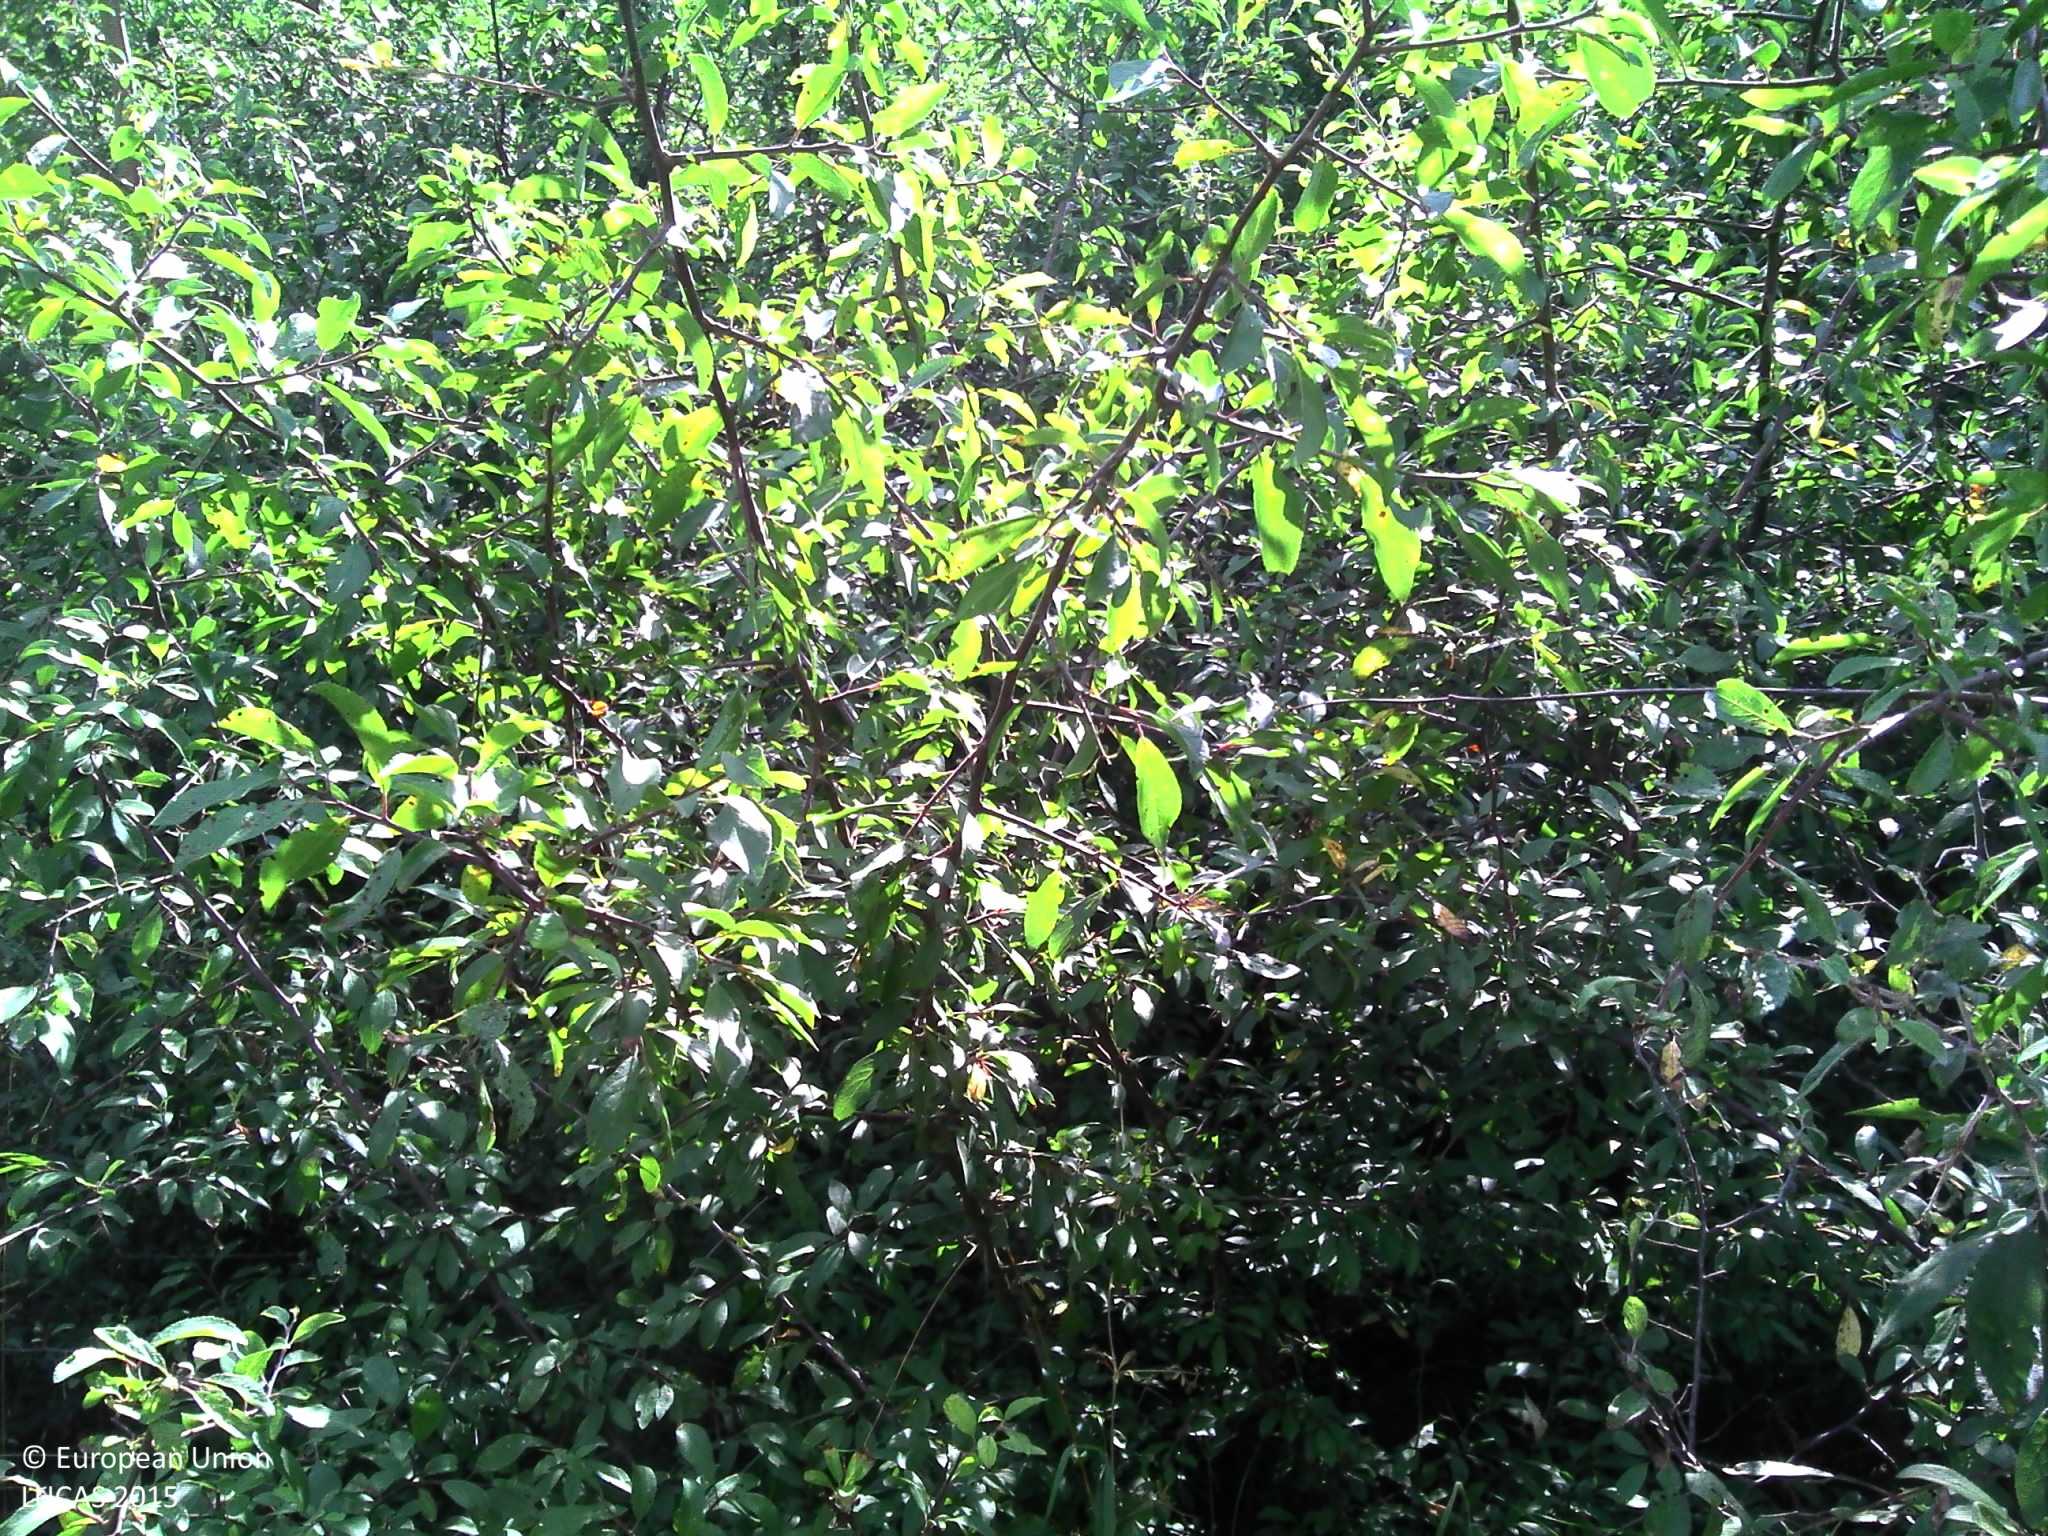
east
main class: Shrubland
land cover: Shrubland with sparse tree cover
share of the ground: 50 - 75 %
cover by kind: shrubs 60 %, herbaceous plants 35 %, broadleaved forest trees 5 %
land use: Forestry
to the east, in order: Shrubland with sparse tree cover; Broadleaved woodland; Grassland without tree/shrub cover; Common wheat; Maize
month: July
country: BE
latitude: 49.7286
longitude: 5.7954
